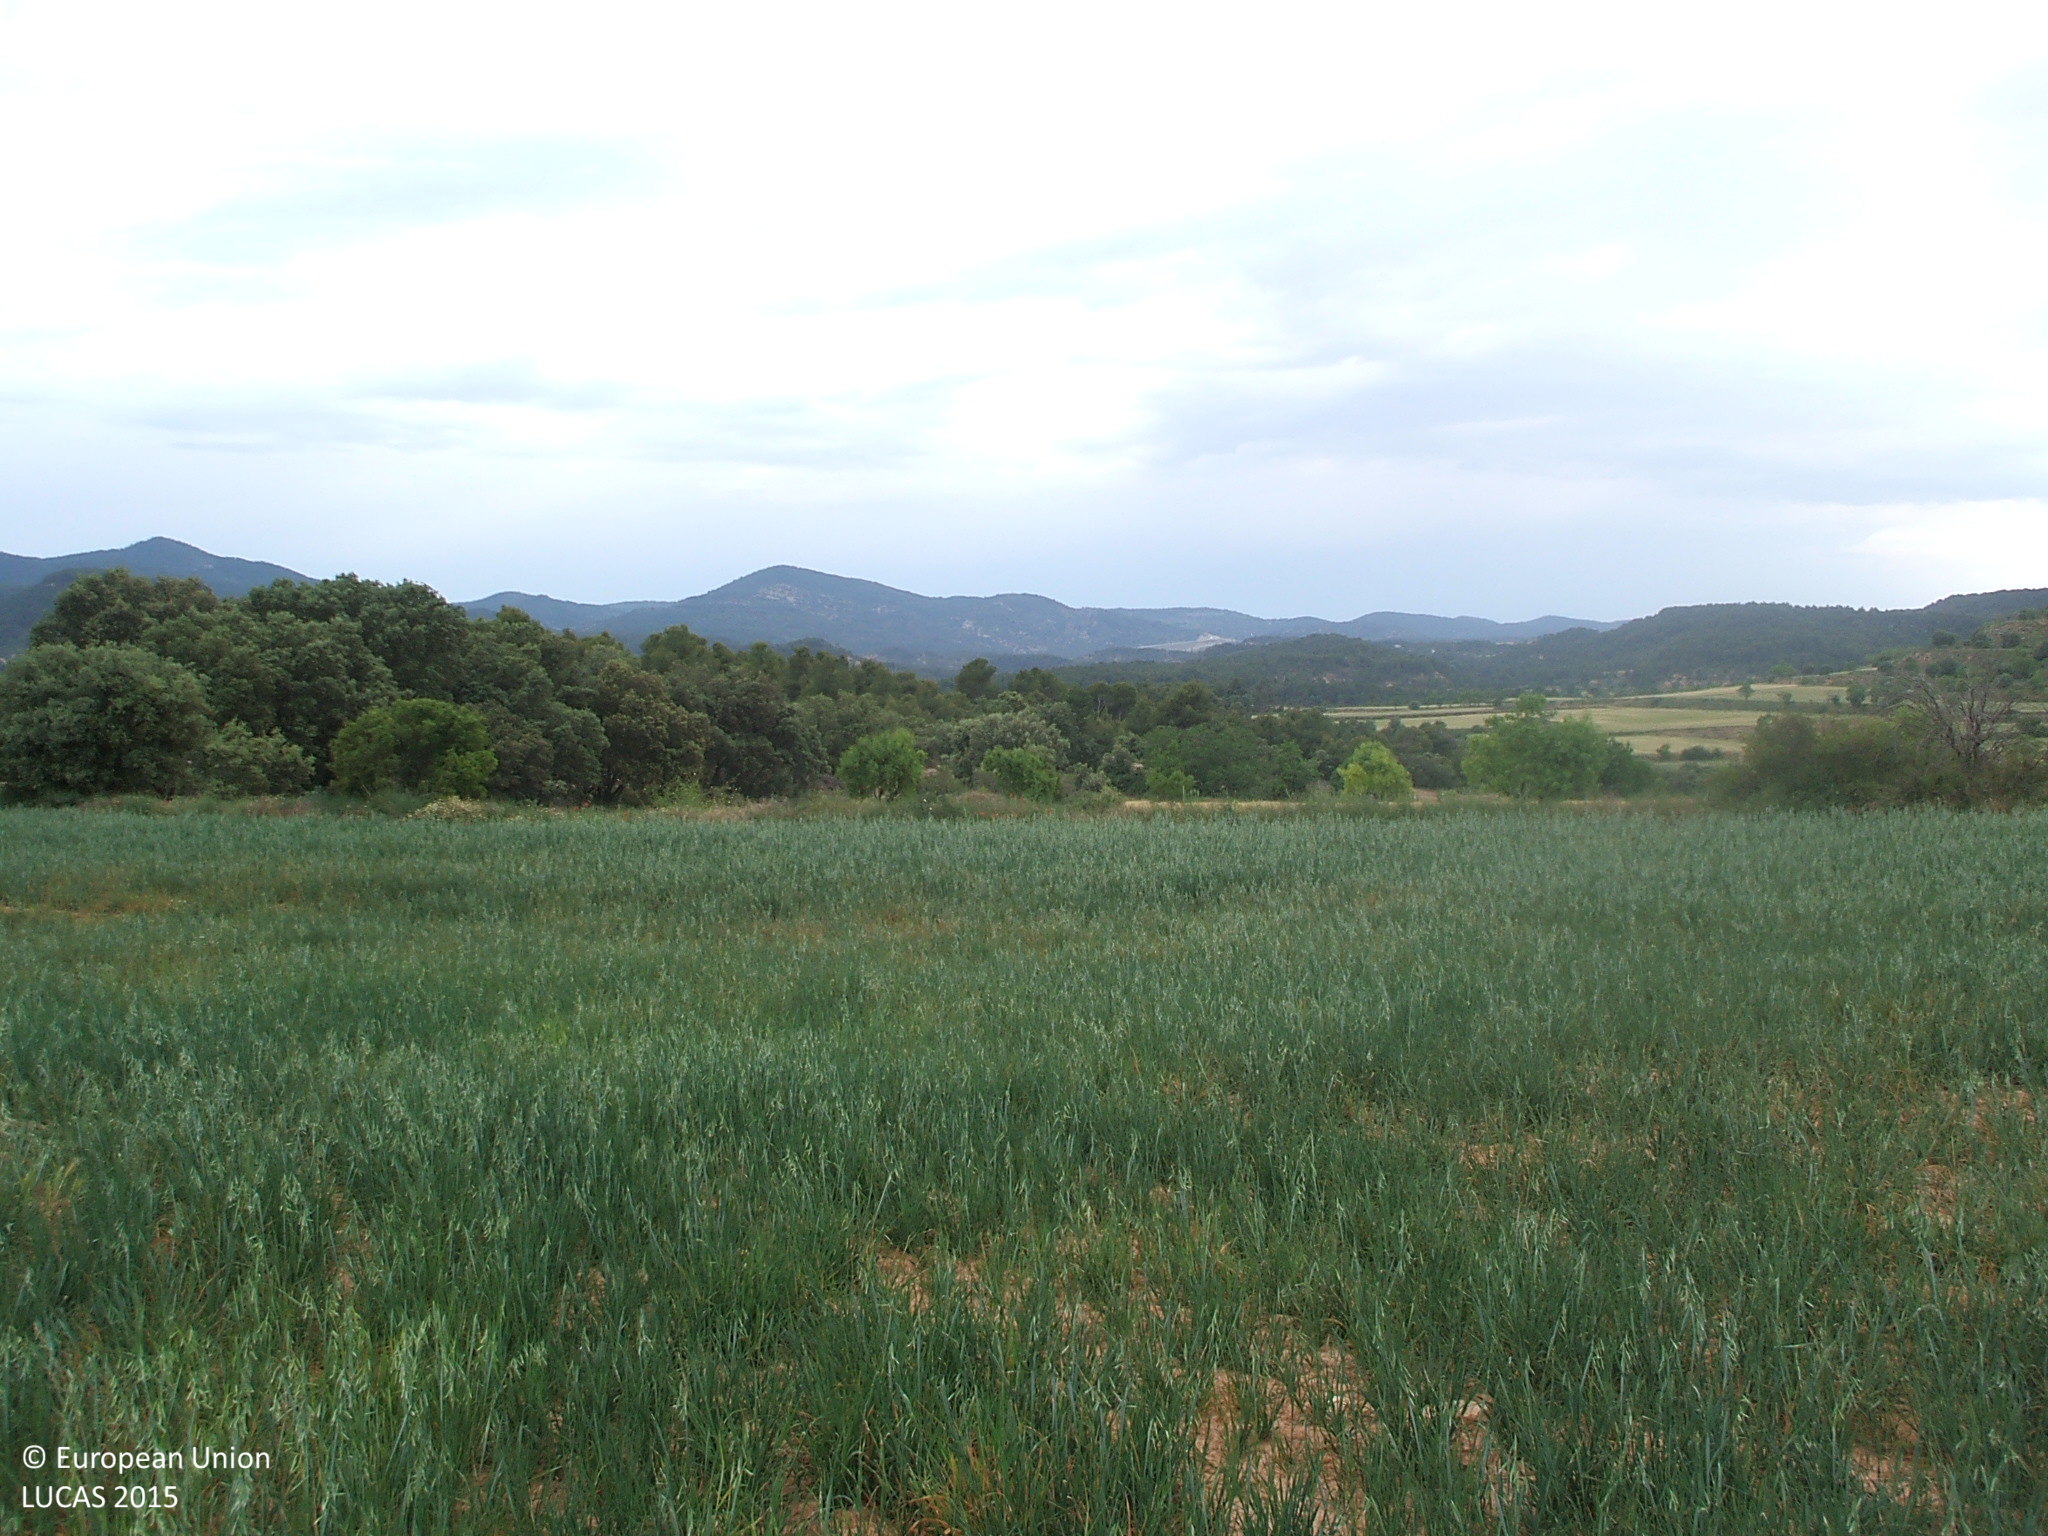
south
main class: Cropland
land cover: Other fresh vegetables
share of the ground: 10 - 25 %
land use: Agriculture (excluding fallow land and kitchen gardens)
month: June
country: ES
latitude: 40.7731
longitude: -0.0198
